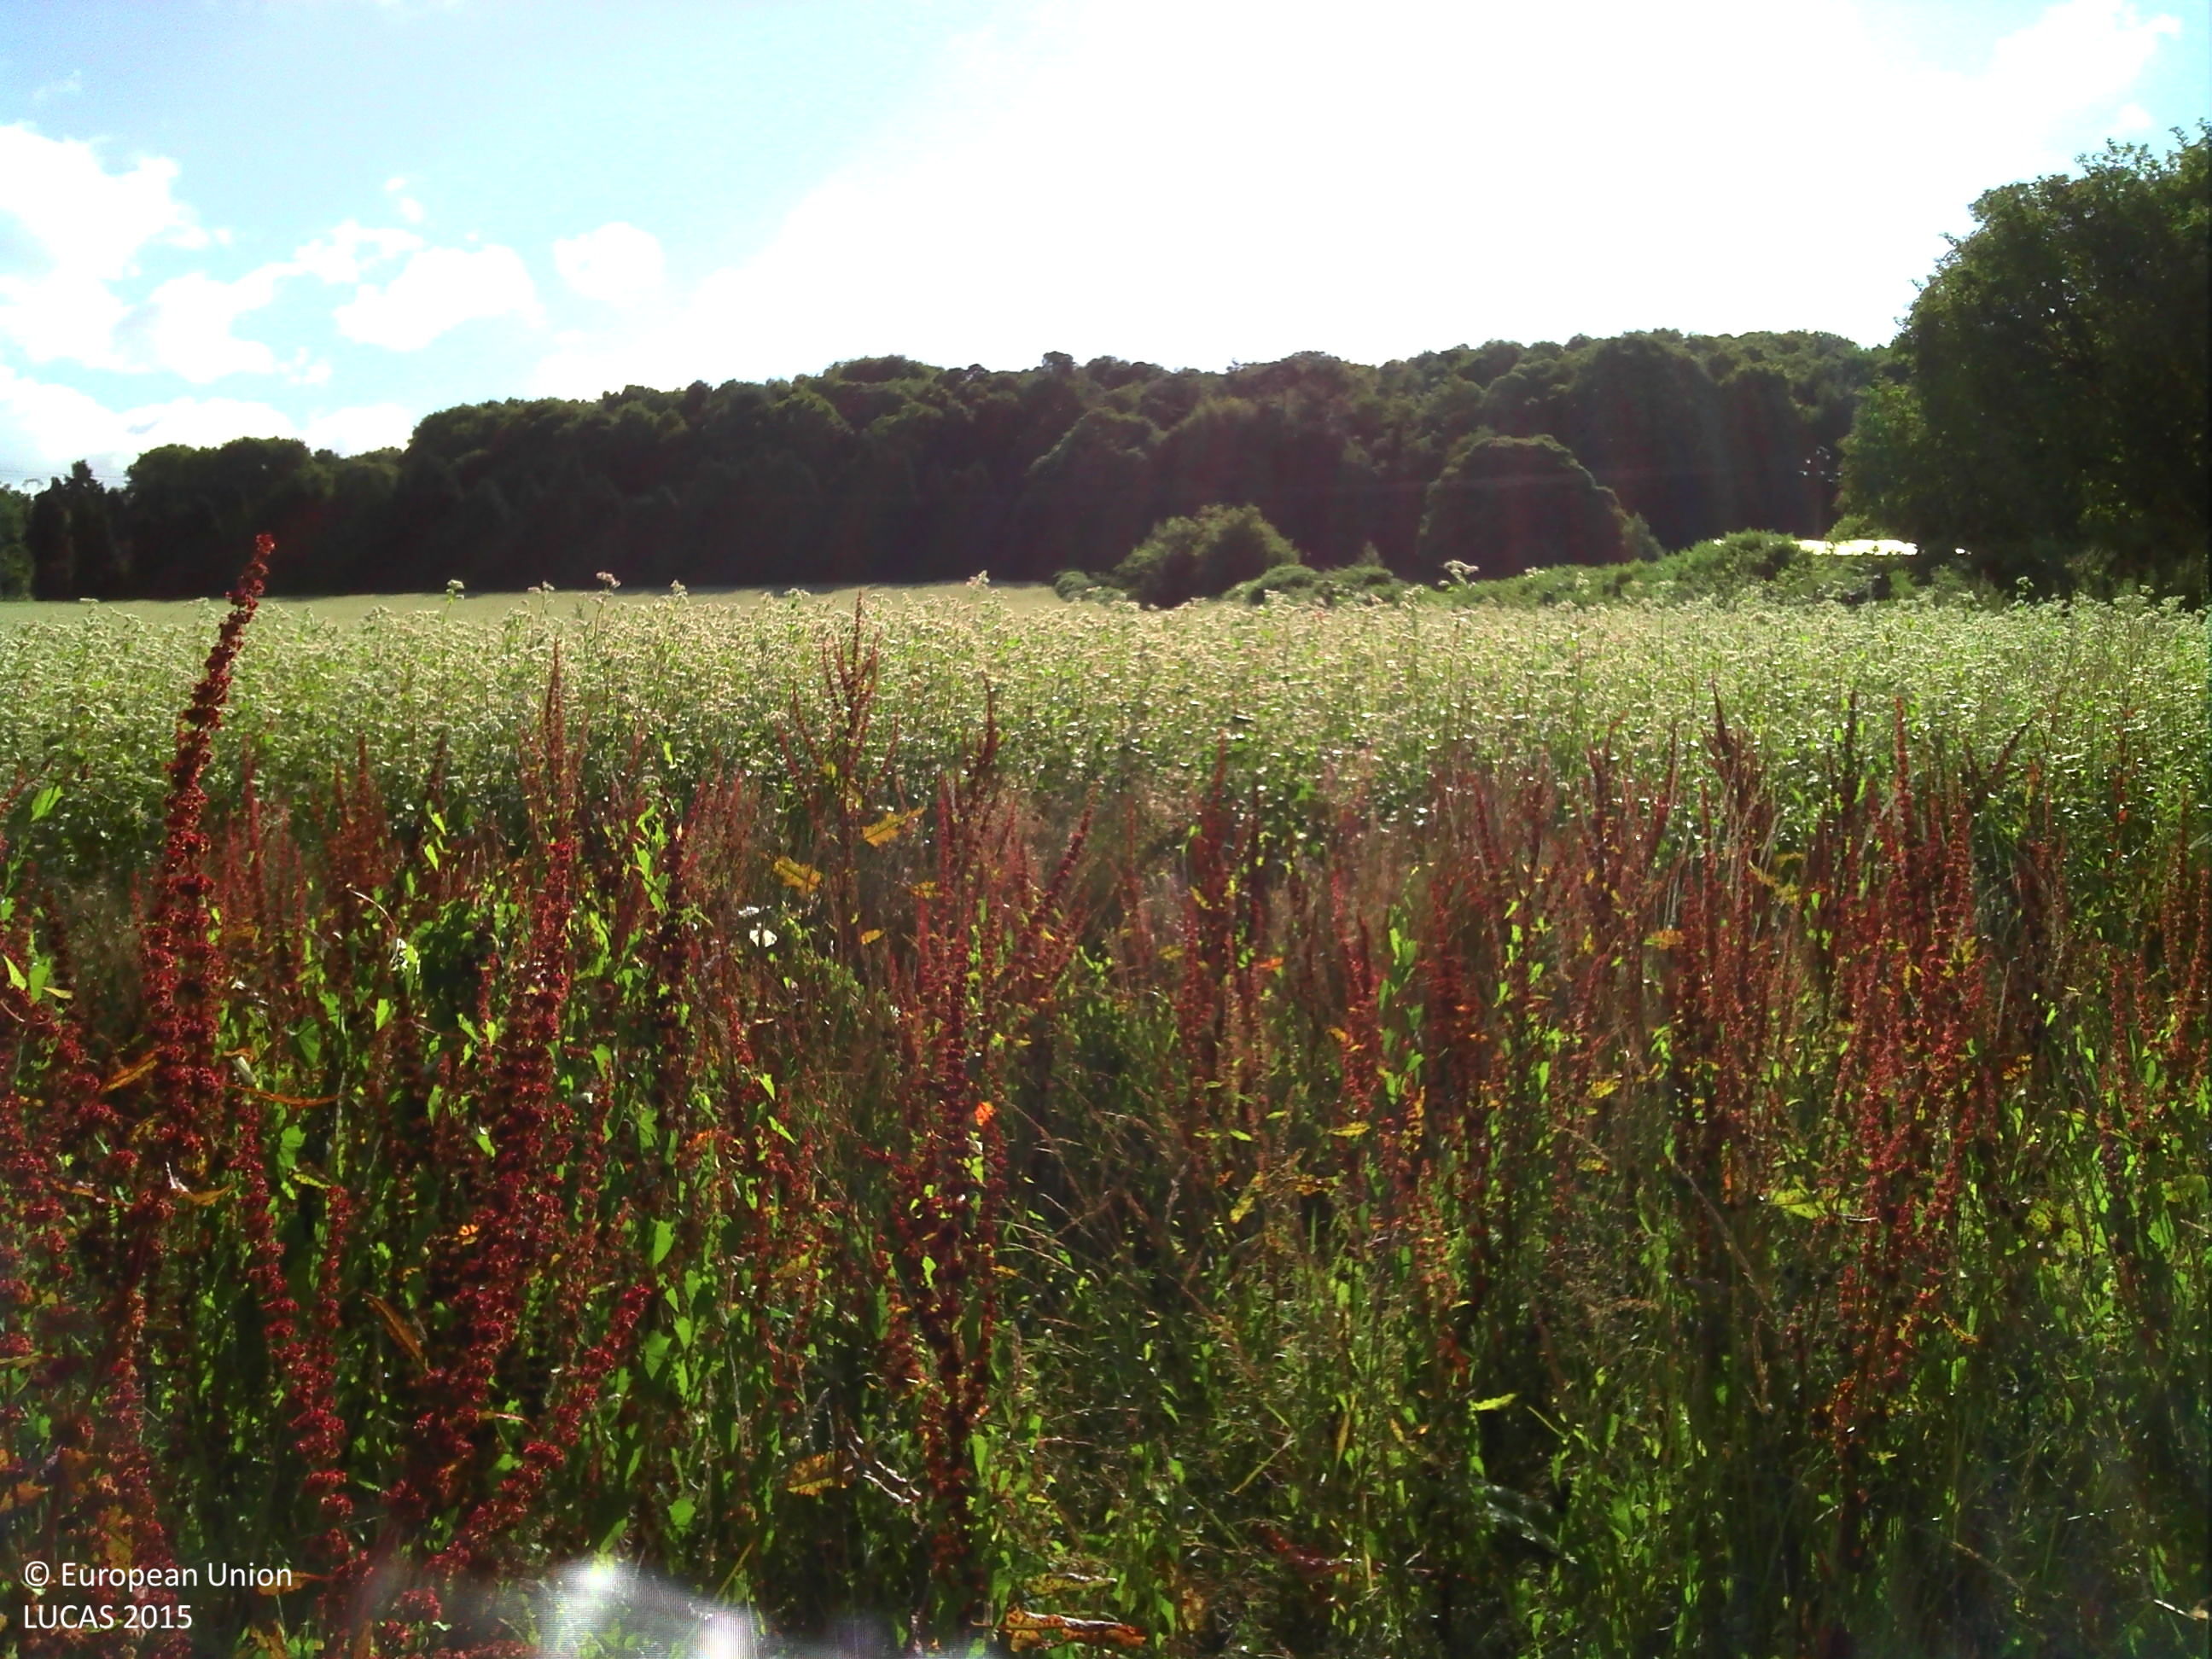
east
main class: Grassland
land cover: Spontaneously vegetated surfaces
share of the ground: > 75 %
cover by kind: herbaceous plants 80 %, consolidated bare surface 10 %, unconsolidated bare surface 10 %
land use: Fallow land
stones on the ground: < 10 %
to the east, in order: Spontaneously vegetated surfaces; Other cereals; Managed hedges; Fences; Grassland without tree/shrub cover; Single bushes/trees; Grassland without tree/shrub cover; Broadleaved woodland
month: July
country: FR
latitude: 47.7830
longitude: -3.1084
